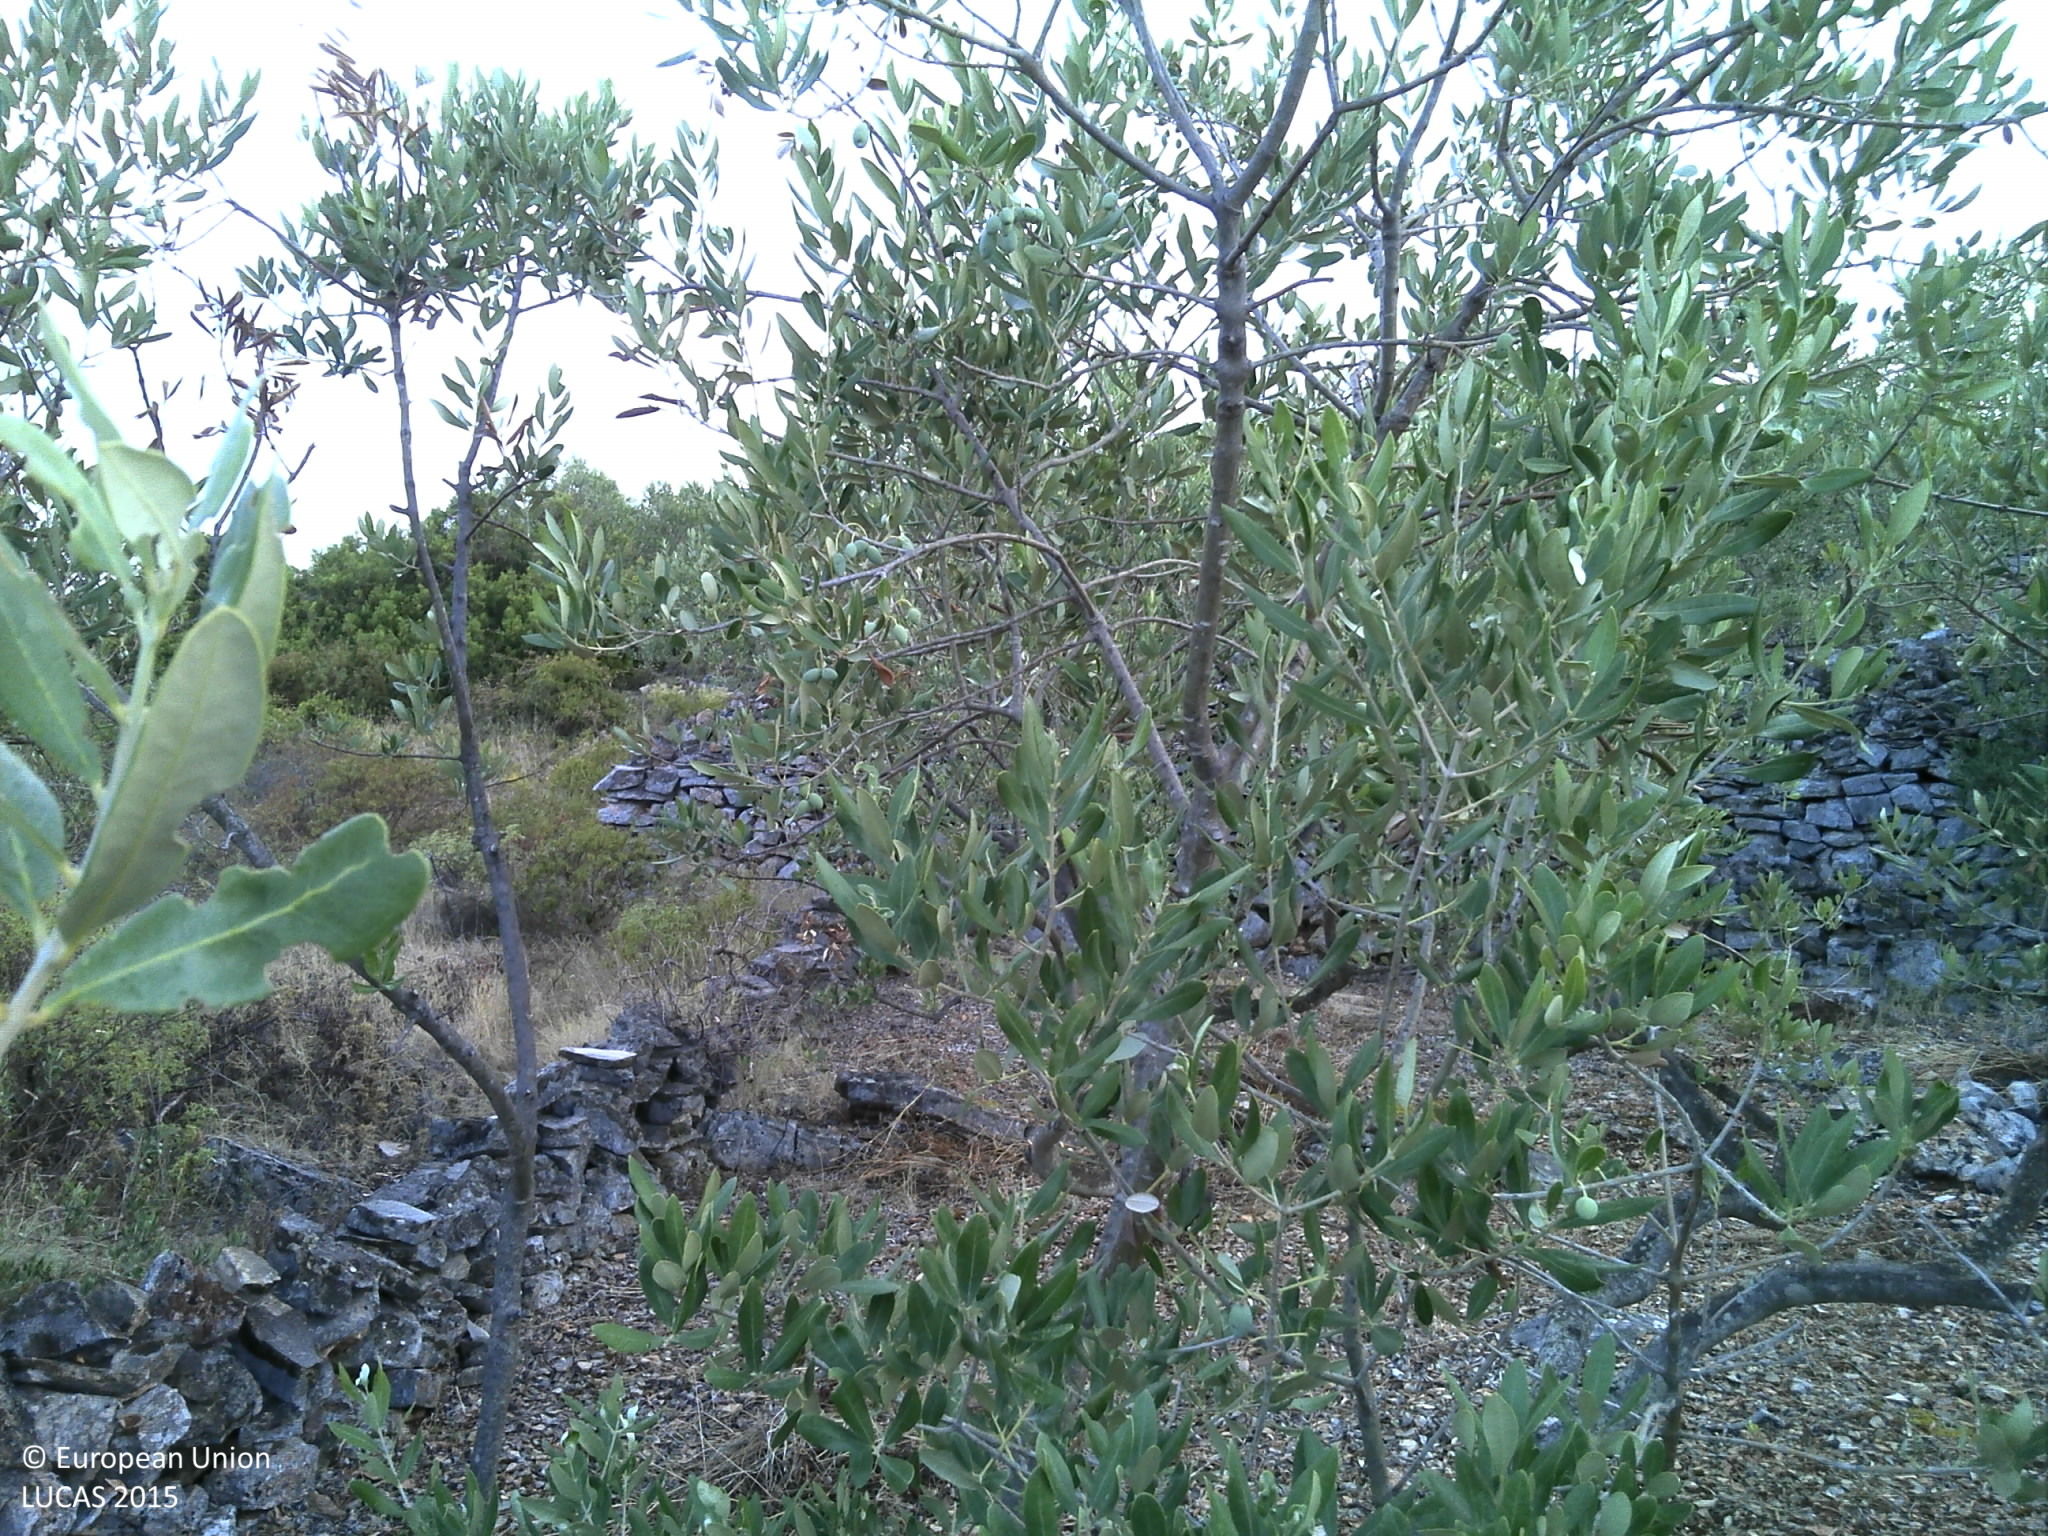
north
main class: Cropland
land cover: Olive groves
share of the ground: 50 - 75 %
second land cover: Other bare soil
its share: > 75 %
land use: Agriculture (excluding fallow land and kitchen gardens)
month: August
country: HR
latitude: 43.4008
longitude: 16.2749
